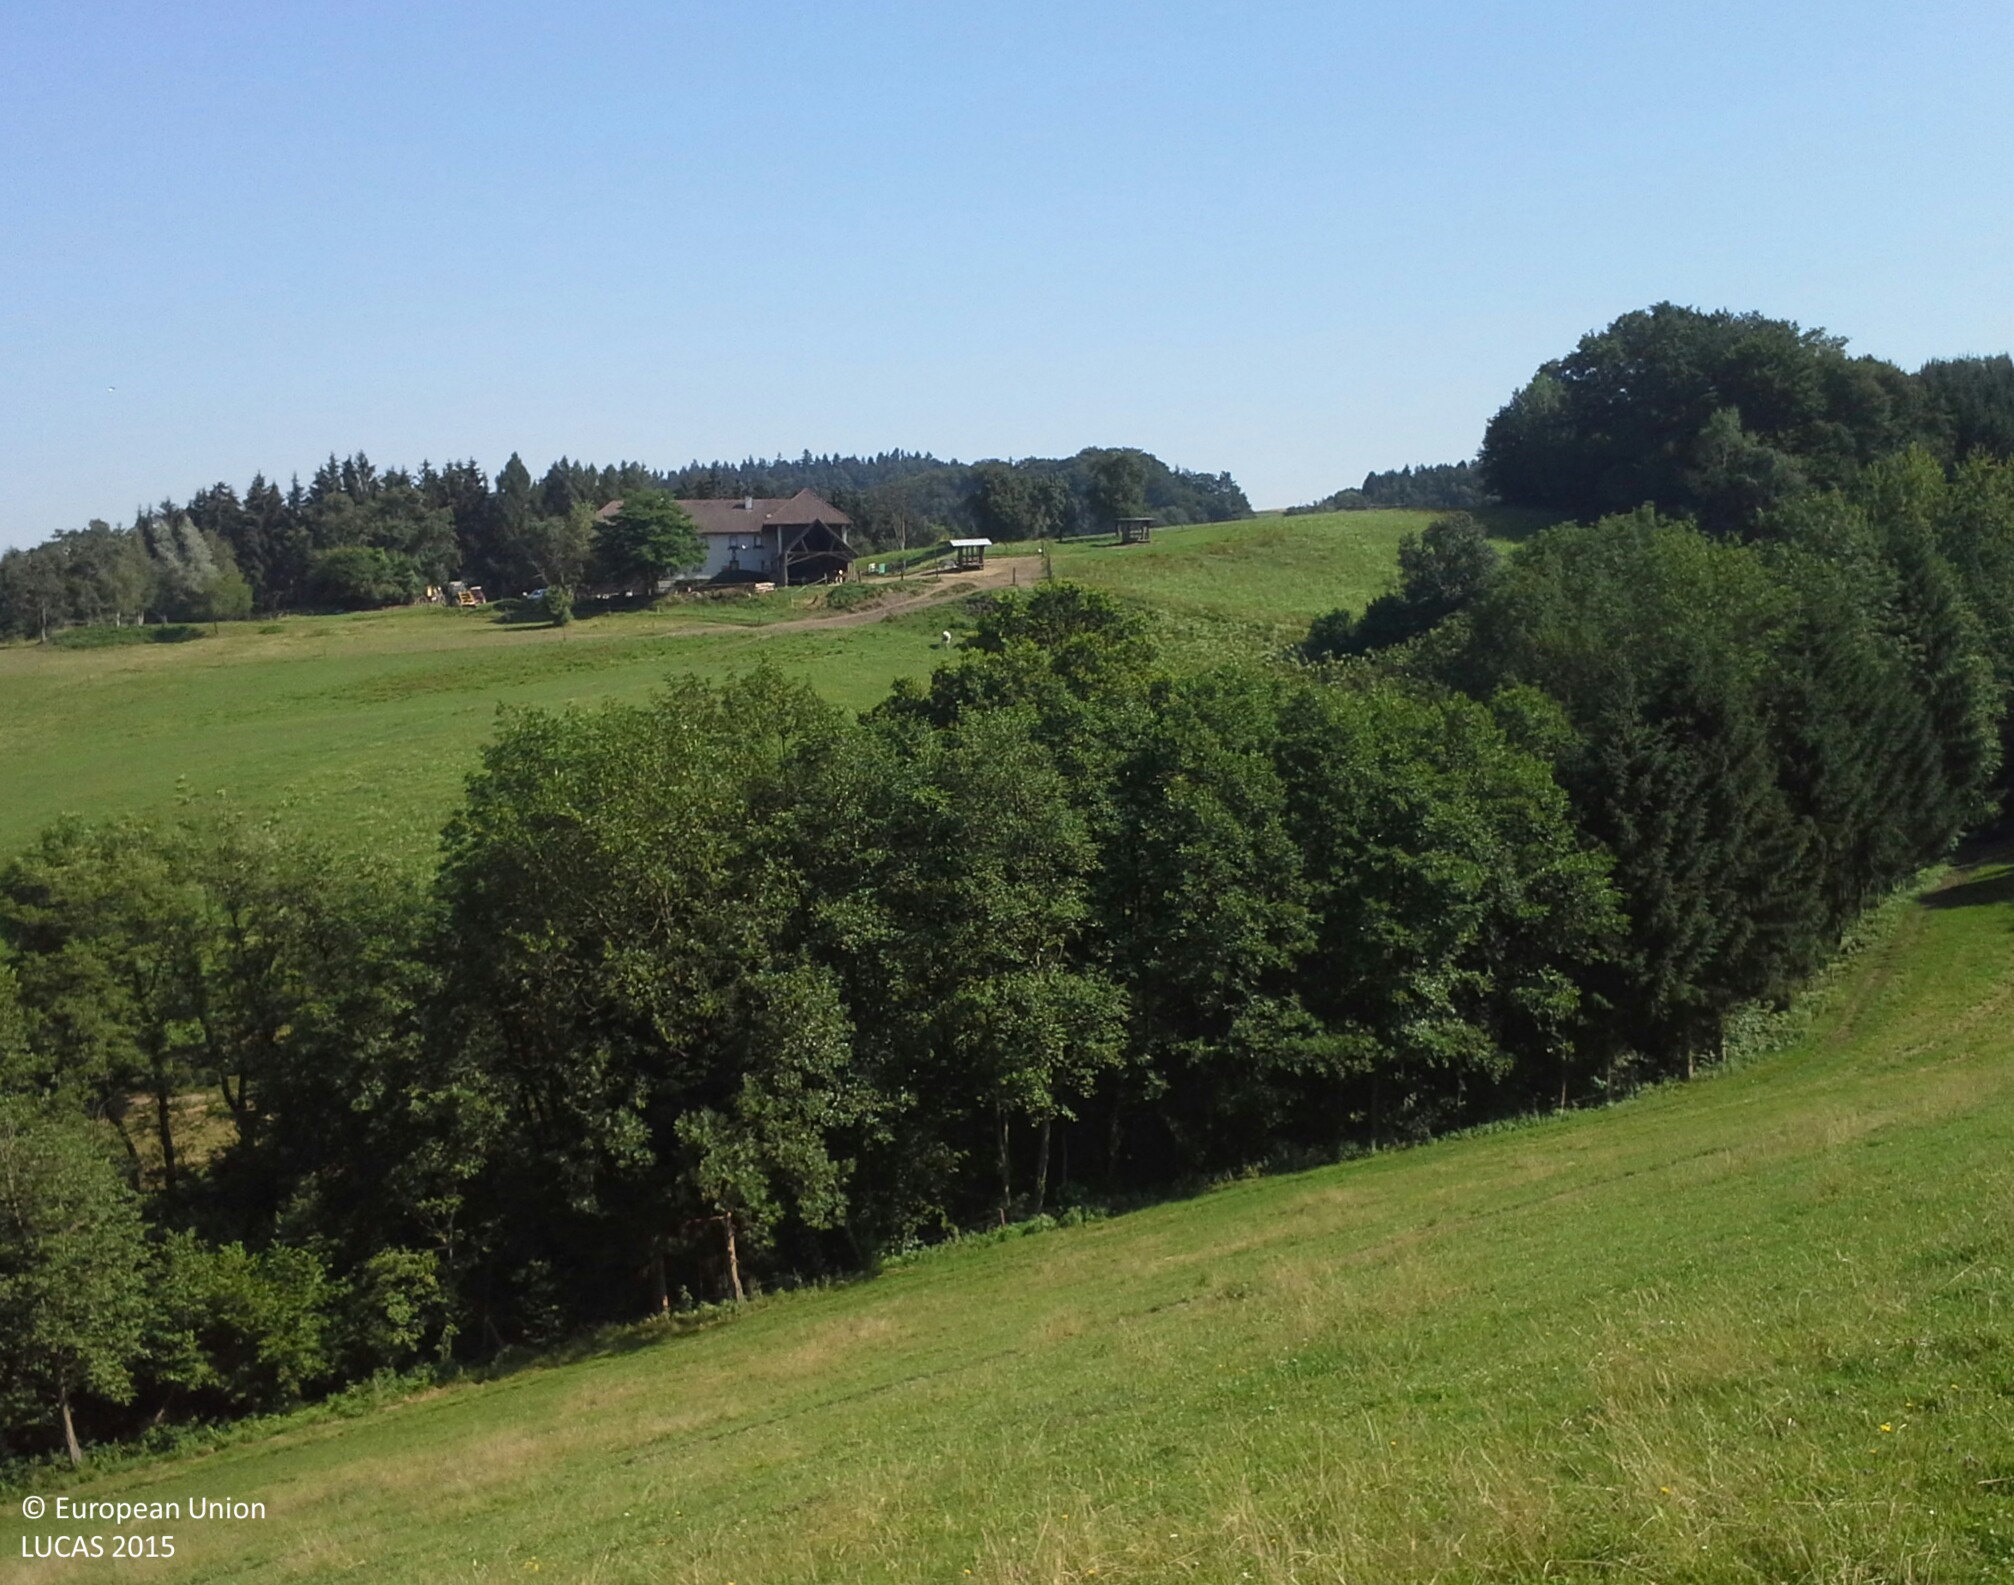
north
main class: Grassland
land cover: Grassland without tree/shrub cover
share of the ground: > 75 %
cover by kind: herbaceous plants 100 %
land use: Agriculture (excluding fallow land and kitchen gardens)
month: July
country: AT
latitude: 48.1887
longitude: 14.8569
